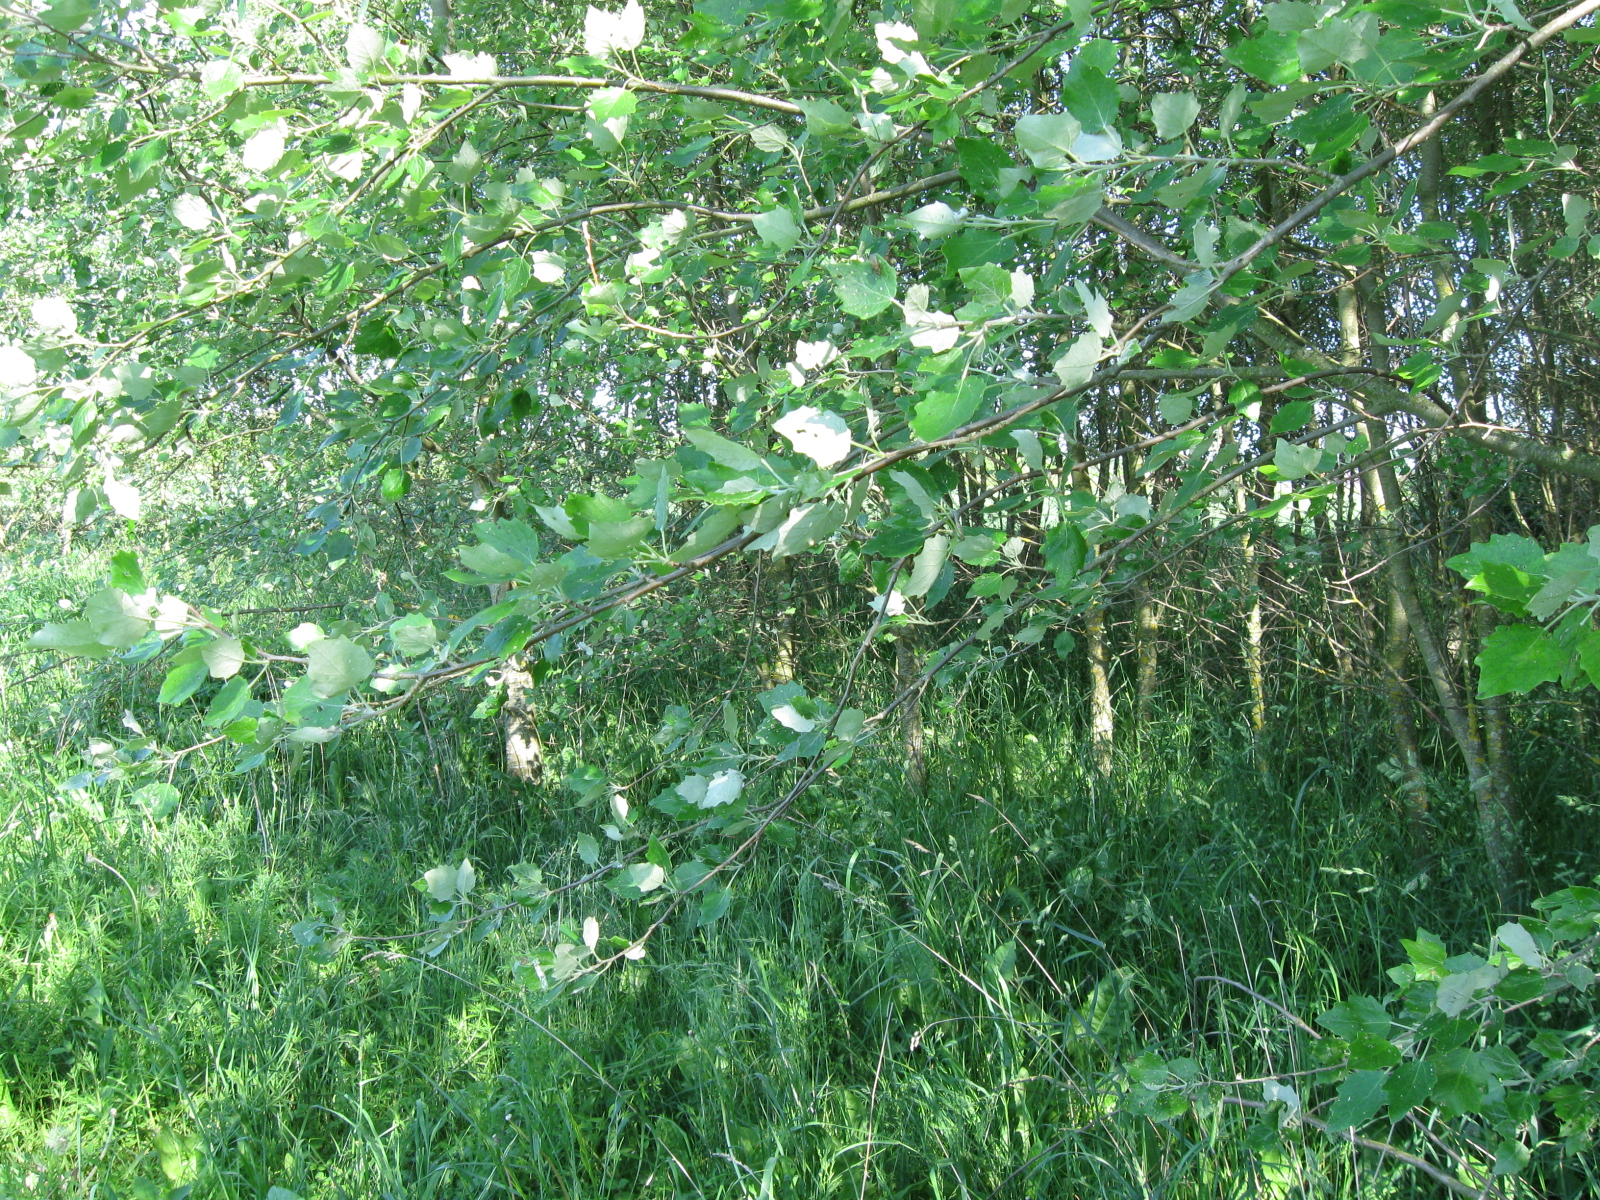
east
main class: Cropland
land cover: Common wheat
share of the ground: > 75 %
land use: Agriculture (excluding fallow land and kitchen gardens)
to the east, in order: Common wheat; Broadleaved woodland; Common wheat; Shruby margins; Paved roads, cycling and walking lanes; Grassland with sparse tree/shrub cover; Electric lines; Barley; Spontaneously vegetated surfaces; Broadleaved woodland; Other mixed woodland; Broadleaved woodland
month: June
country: LT
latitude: 54.8168
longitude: 23.9562
